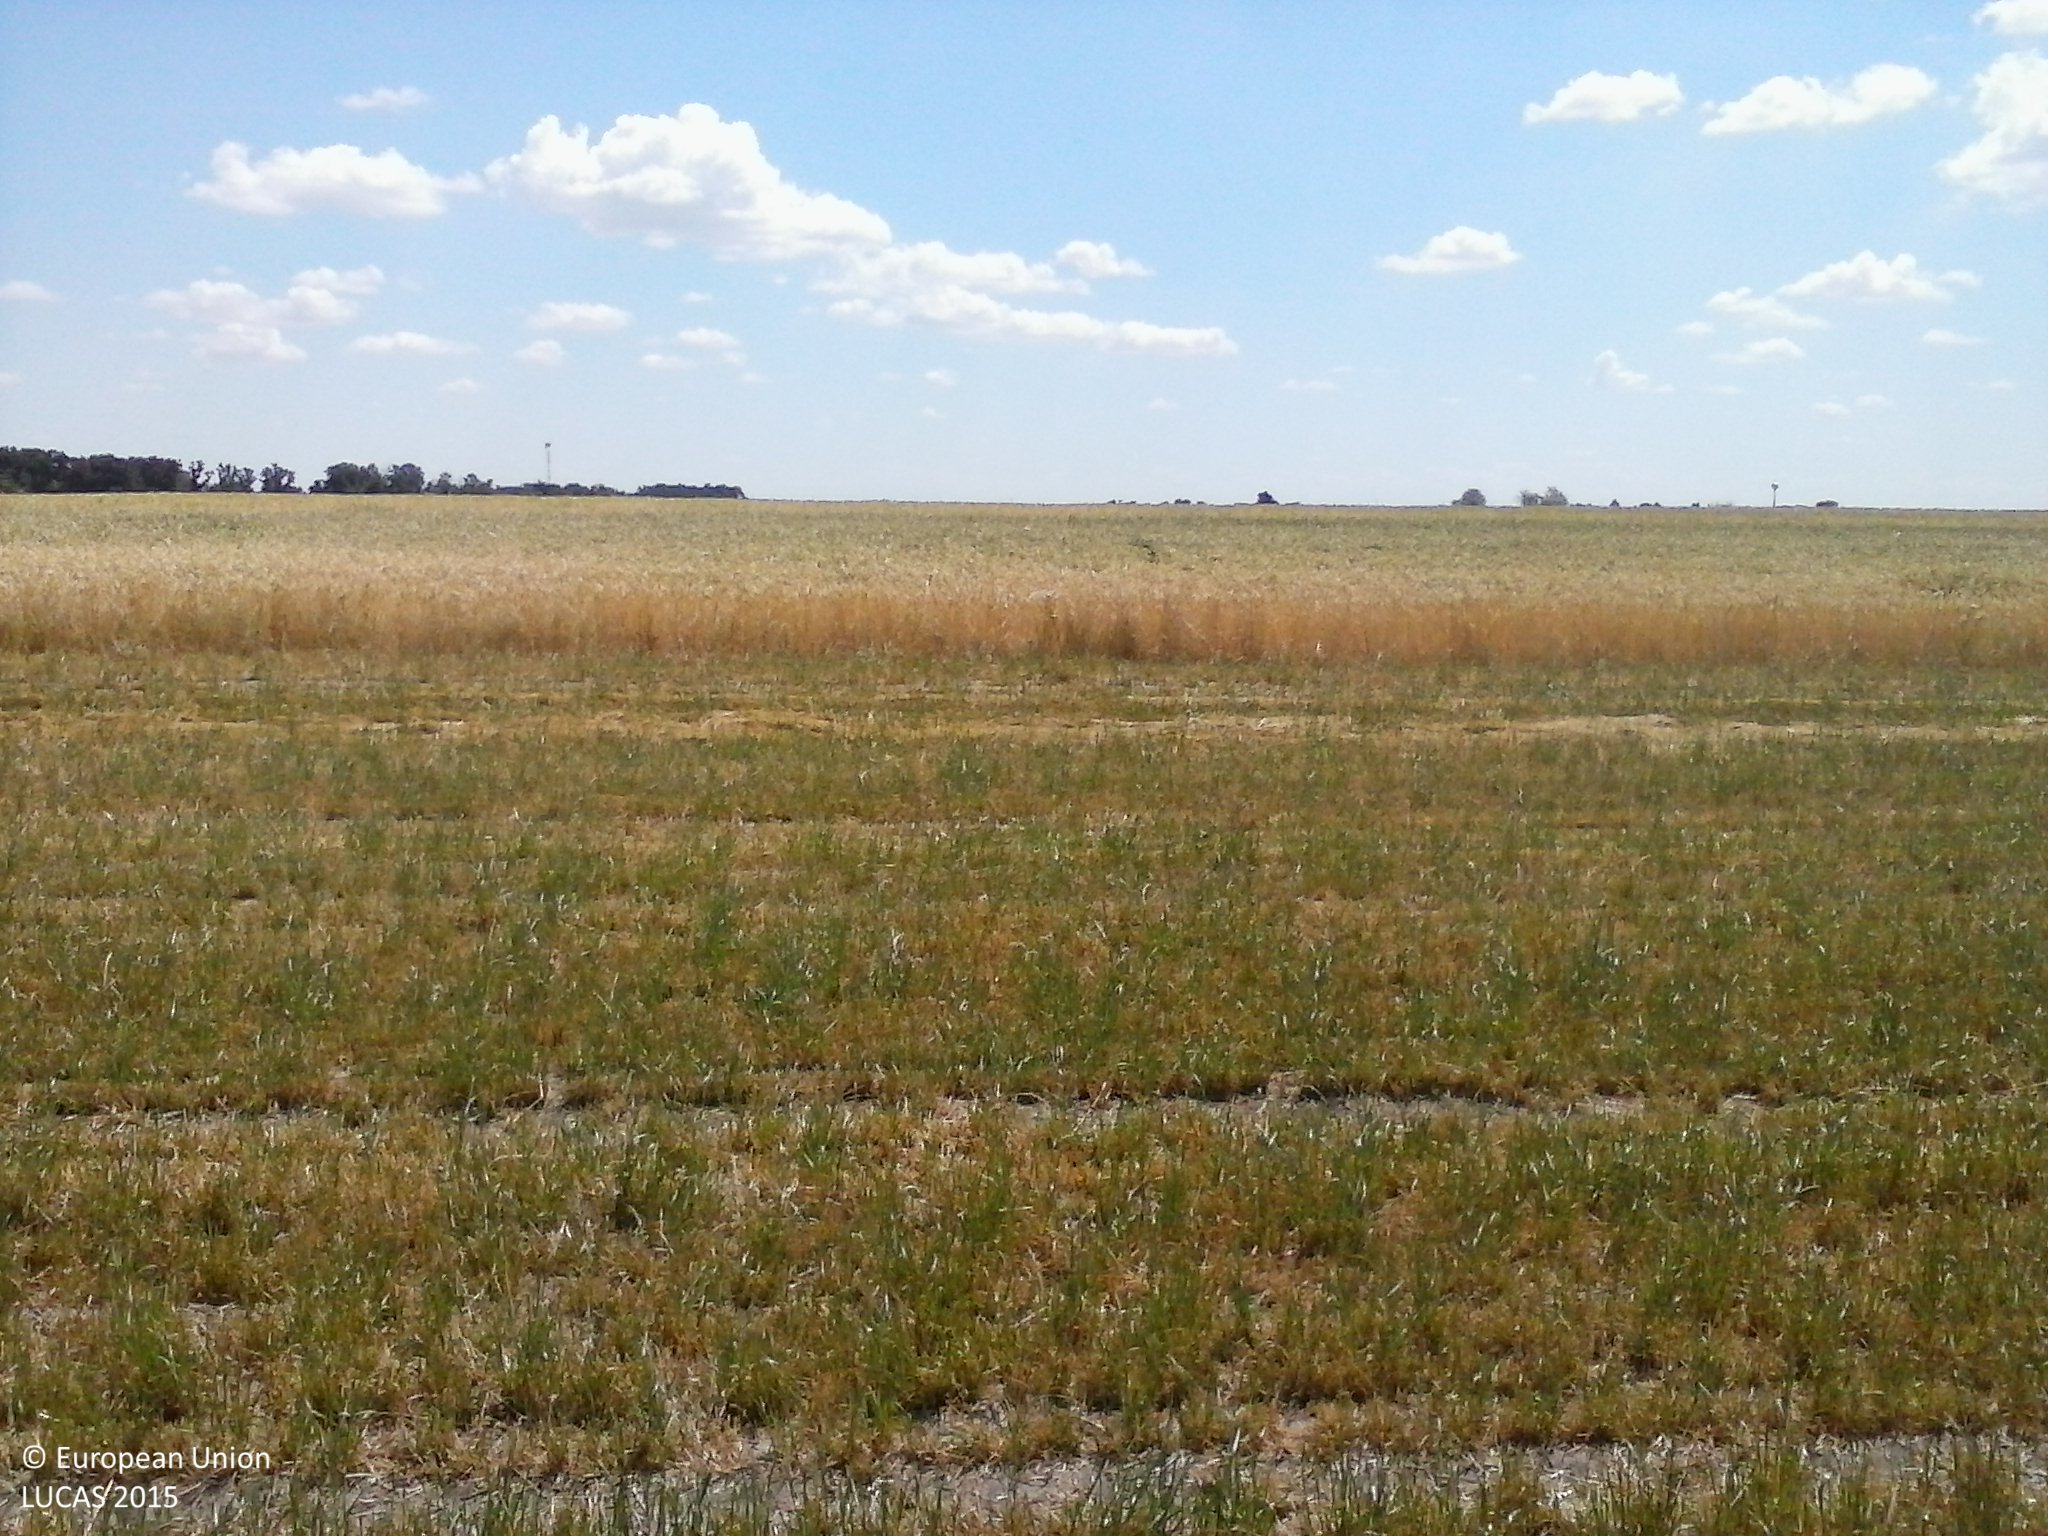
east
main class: Cropland
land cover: Common wheat
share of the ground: < 10 %
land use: Agriculture (excluding fallow land and kitchen gardens)
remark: Harvested field
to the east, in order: Common wheat
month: June
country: HU
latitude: 46.2154
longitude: 20.3027
